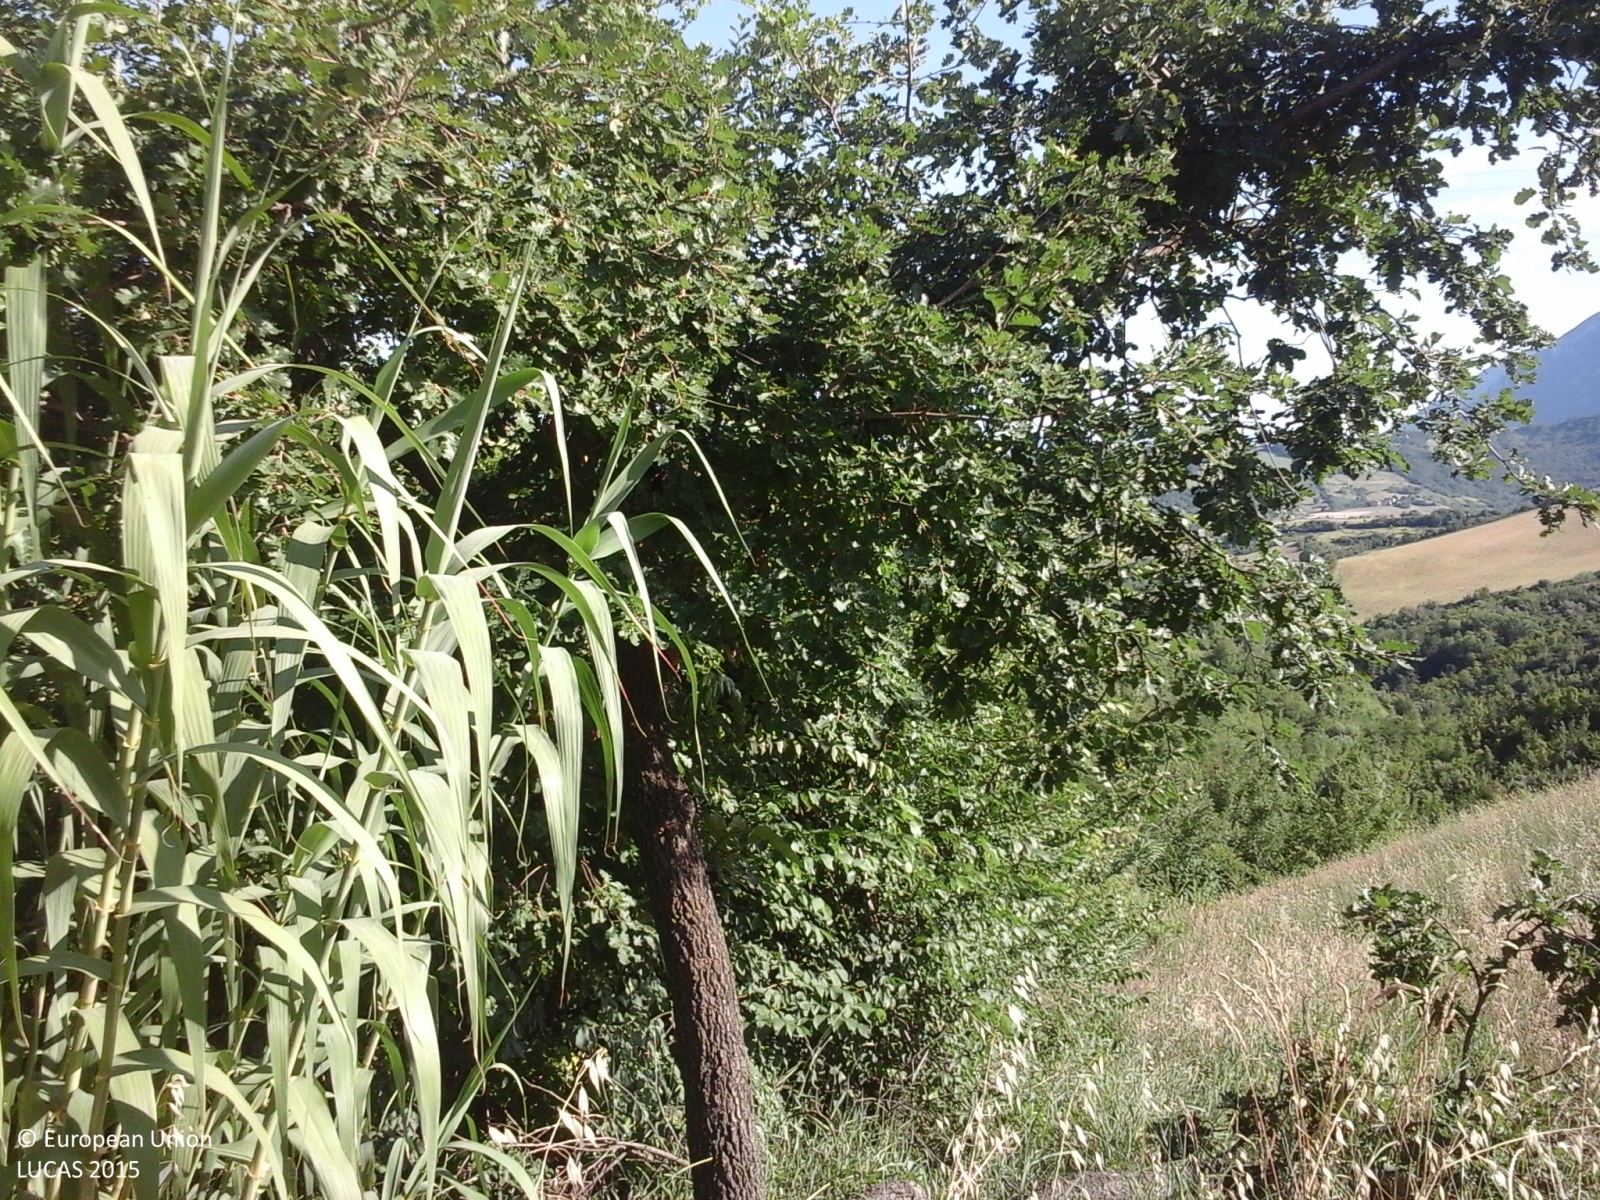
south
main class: Cropland
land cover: Durum wheat
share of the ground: > 75 %
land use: Agriculture (excluding fallow land and kitchen gardens)
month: June
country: IT
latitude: 42.1856
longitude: 14.2366
